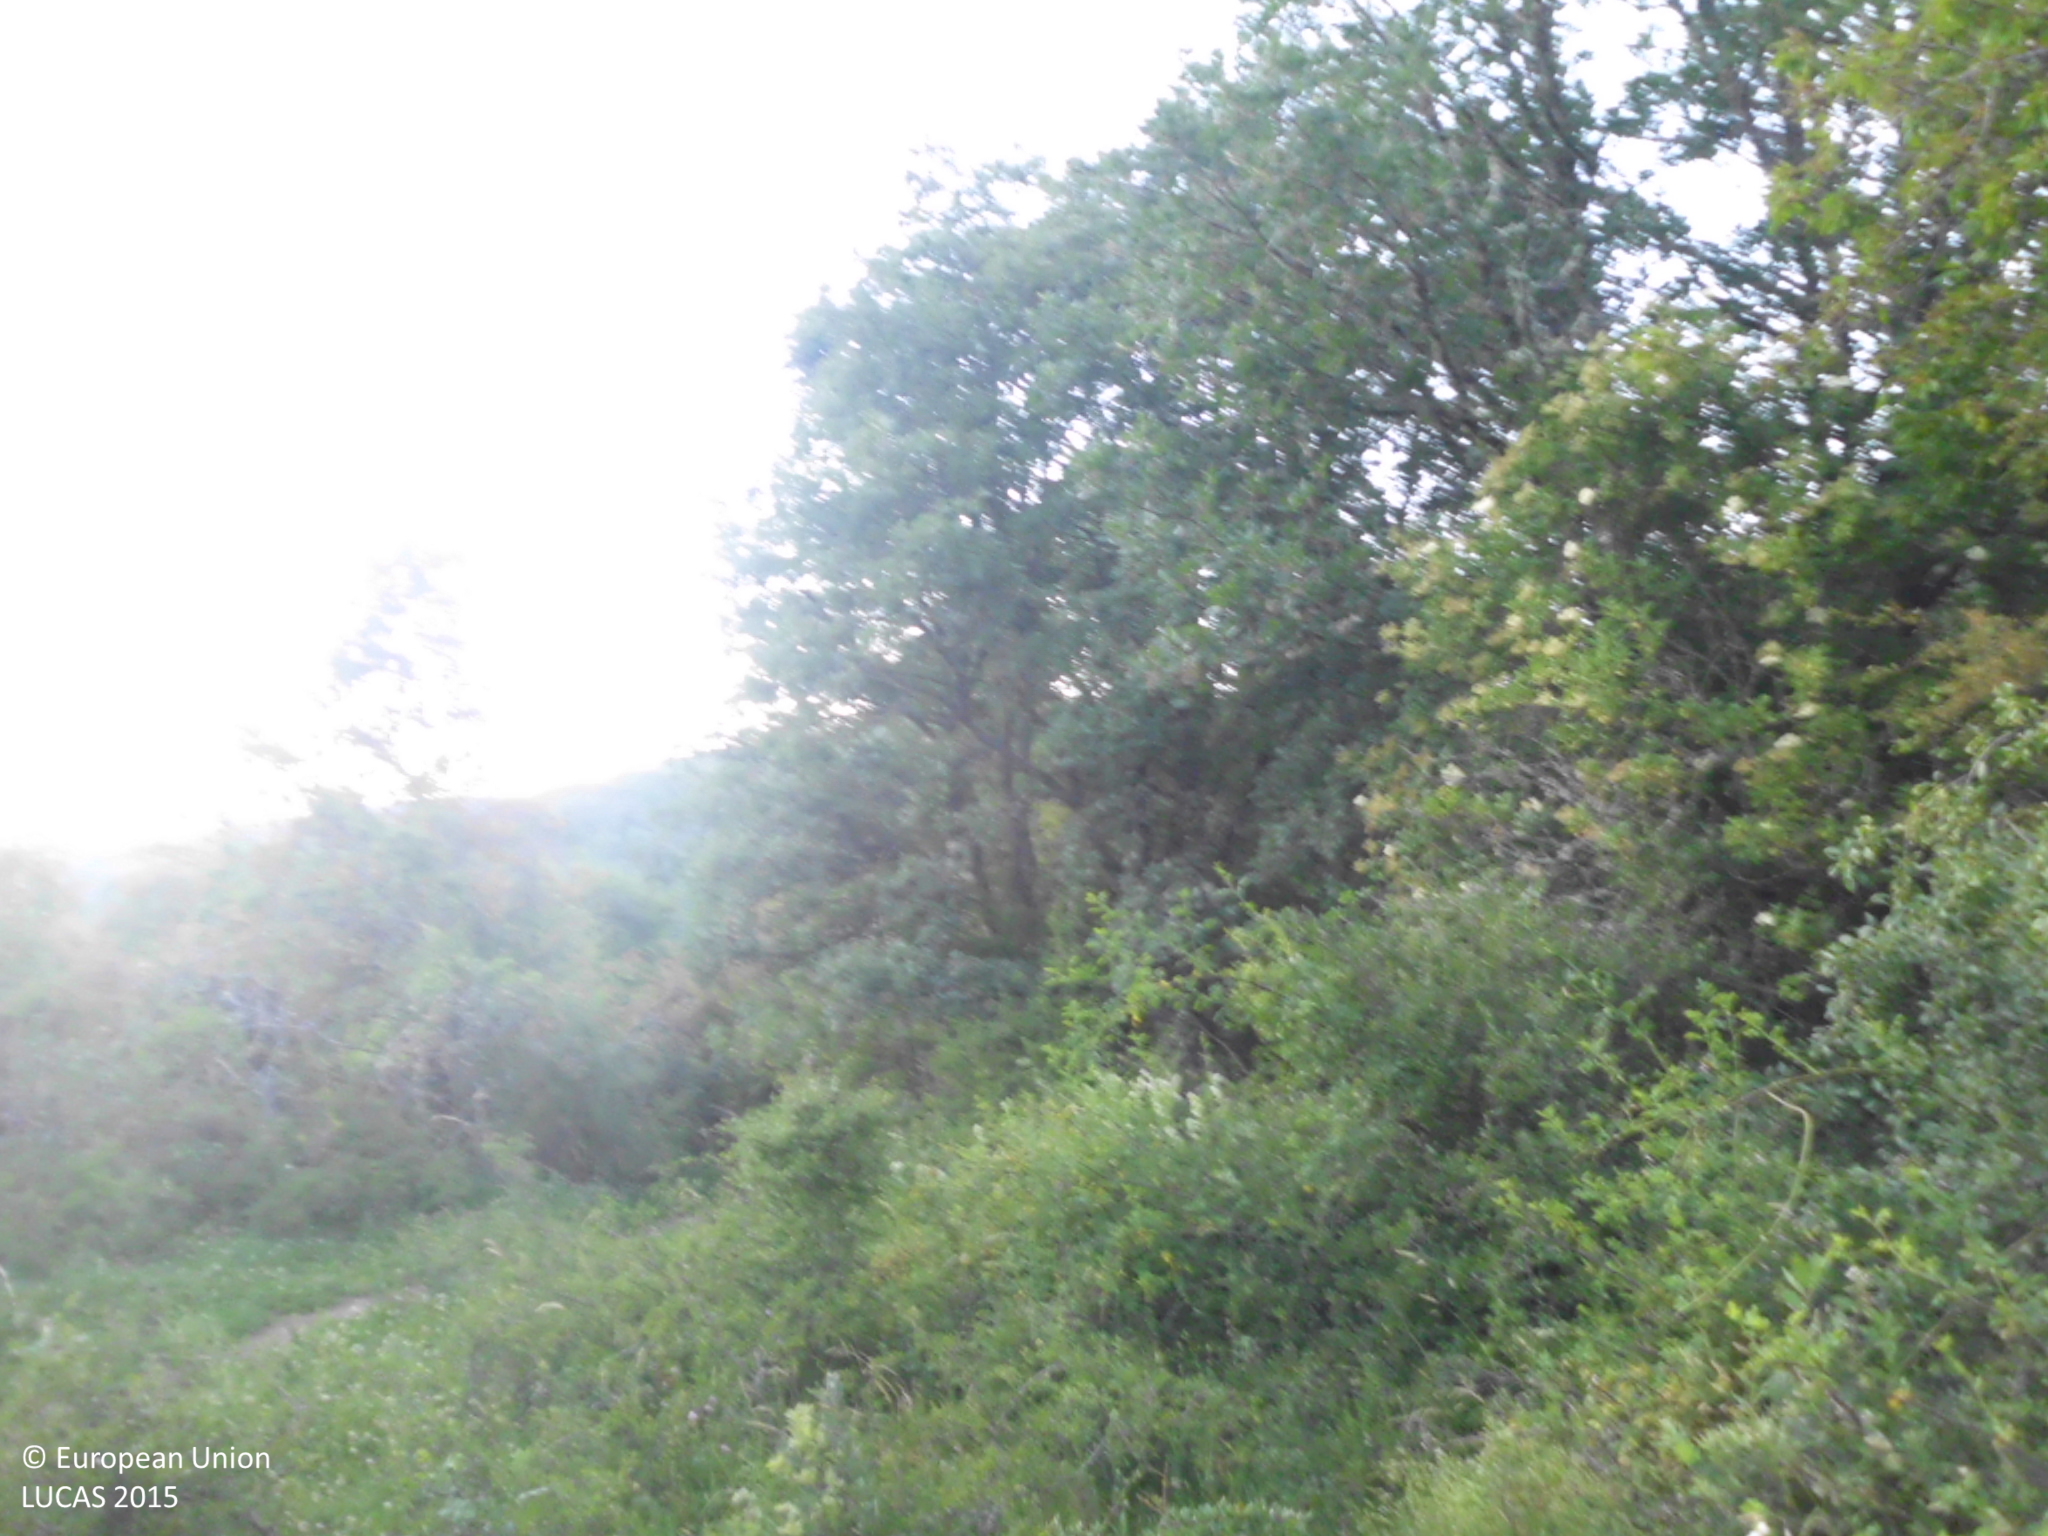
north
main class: Grassland
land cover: Grassland without tree/shrub cover
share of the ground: > 75 %
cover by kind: herbaceous plants 95 %, shrubs 5 %
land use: Abandoned areas
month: June
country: ES
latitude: 42.8384
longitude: -4.9528
